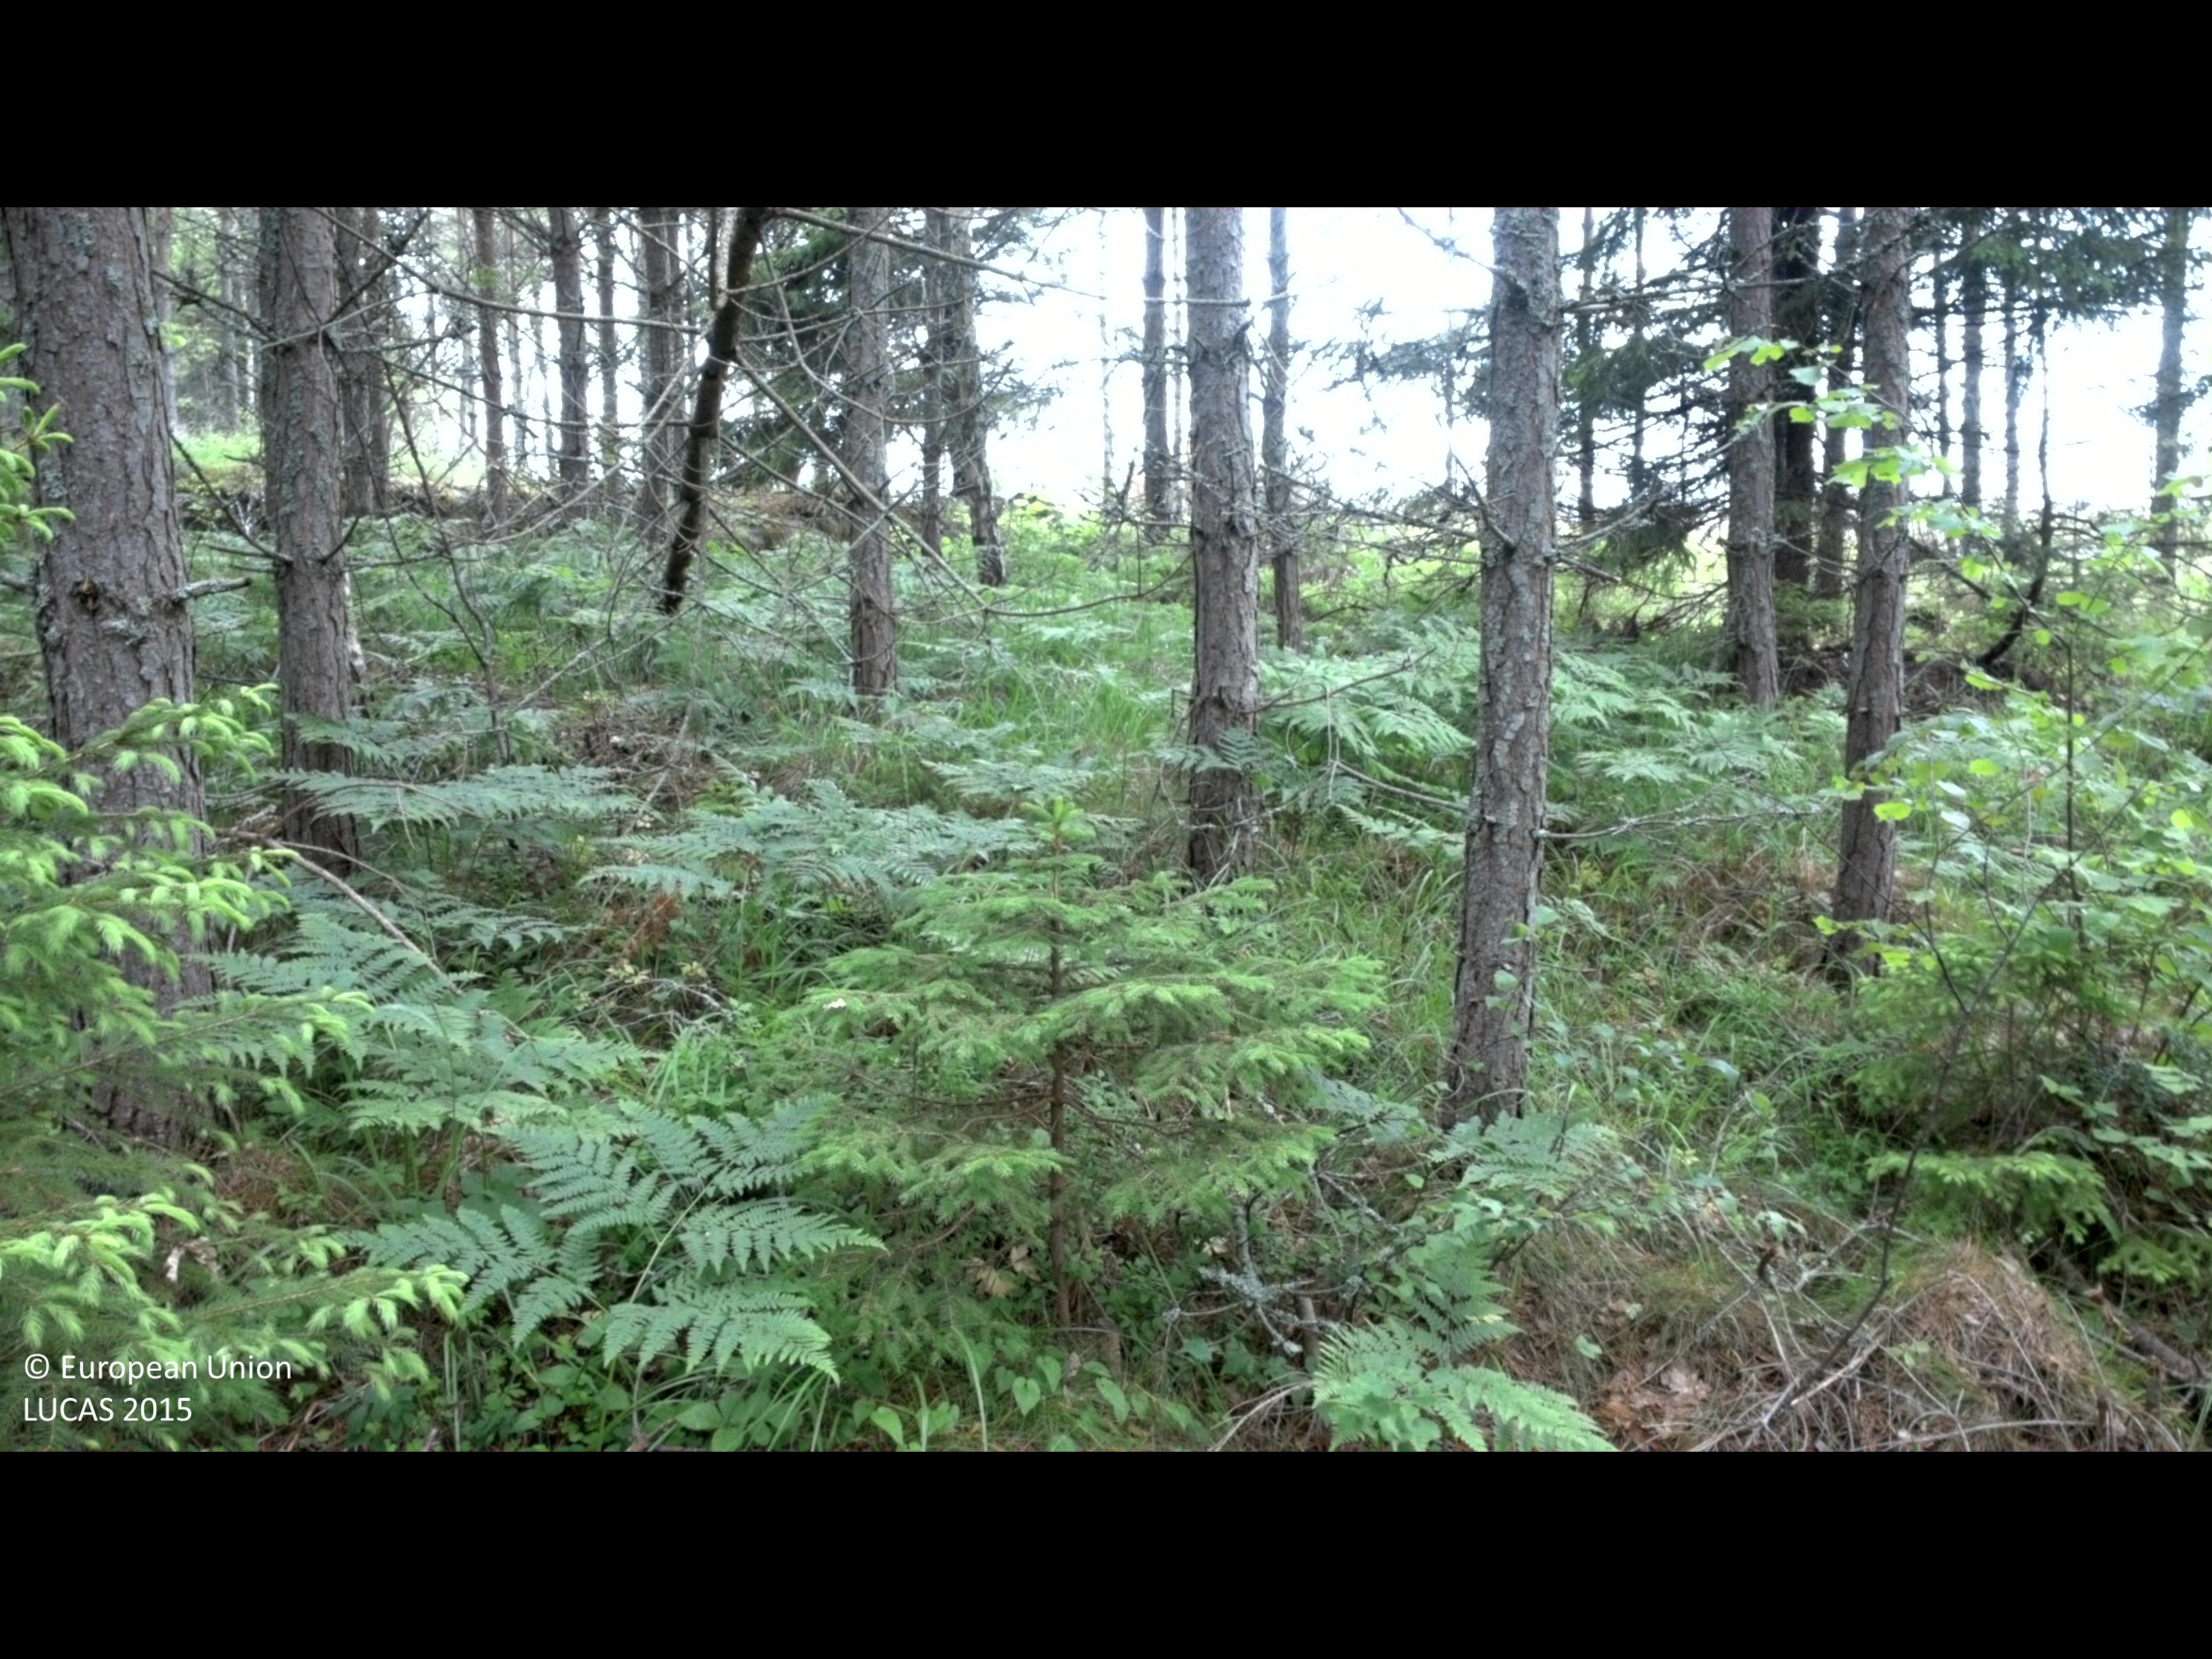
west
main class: Woodland
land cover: Pine dominated coniferous woodland
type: boreal forest
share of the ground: > 75 %
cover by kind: coniferous forest trees 65 %, broadleaved forest trees 15 %, shrubs 15 %, herbaceous plants 5 %
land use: Forestry
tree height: > 5 m
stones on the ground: 25 - 50 %
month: June
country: SE
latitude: 58.0024
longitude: 16.2406
